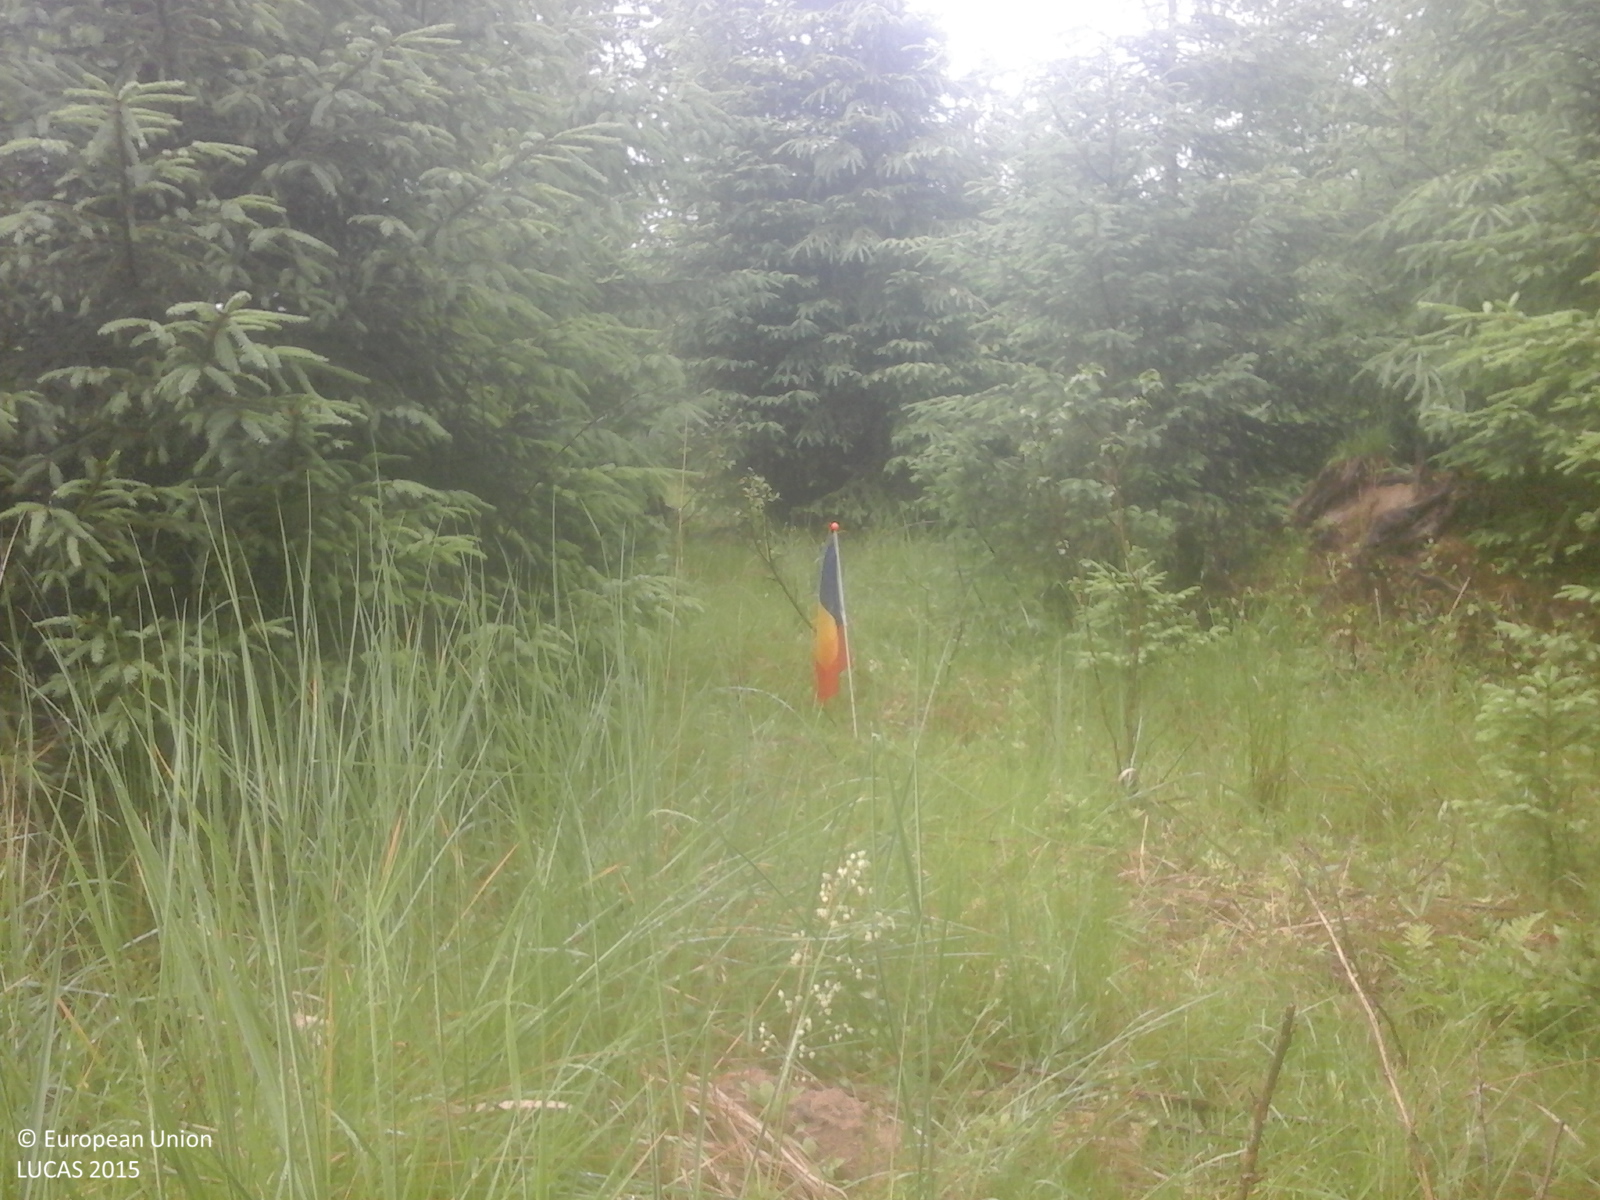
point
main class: Woodland
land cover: Spruce dominated coniferous woodland
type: alpine coniferous forest
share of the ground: > 75 %
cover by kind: coniferous forest trees 85 %, herbaceous plants 15 %
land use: Forestry
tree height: > 5 m
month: June
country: RO
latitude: 47.5351
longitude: 25.7853
